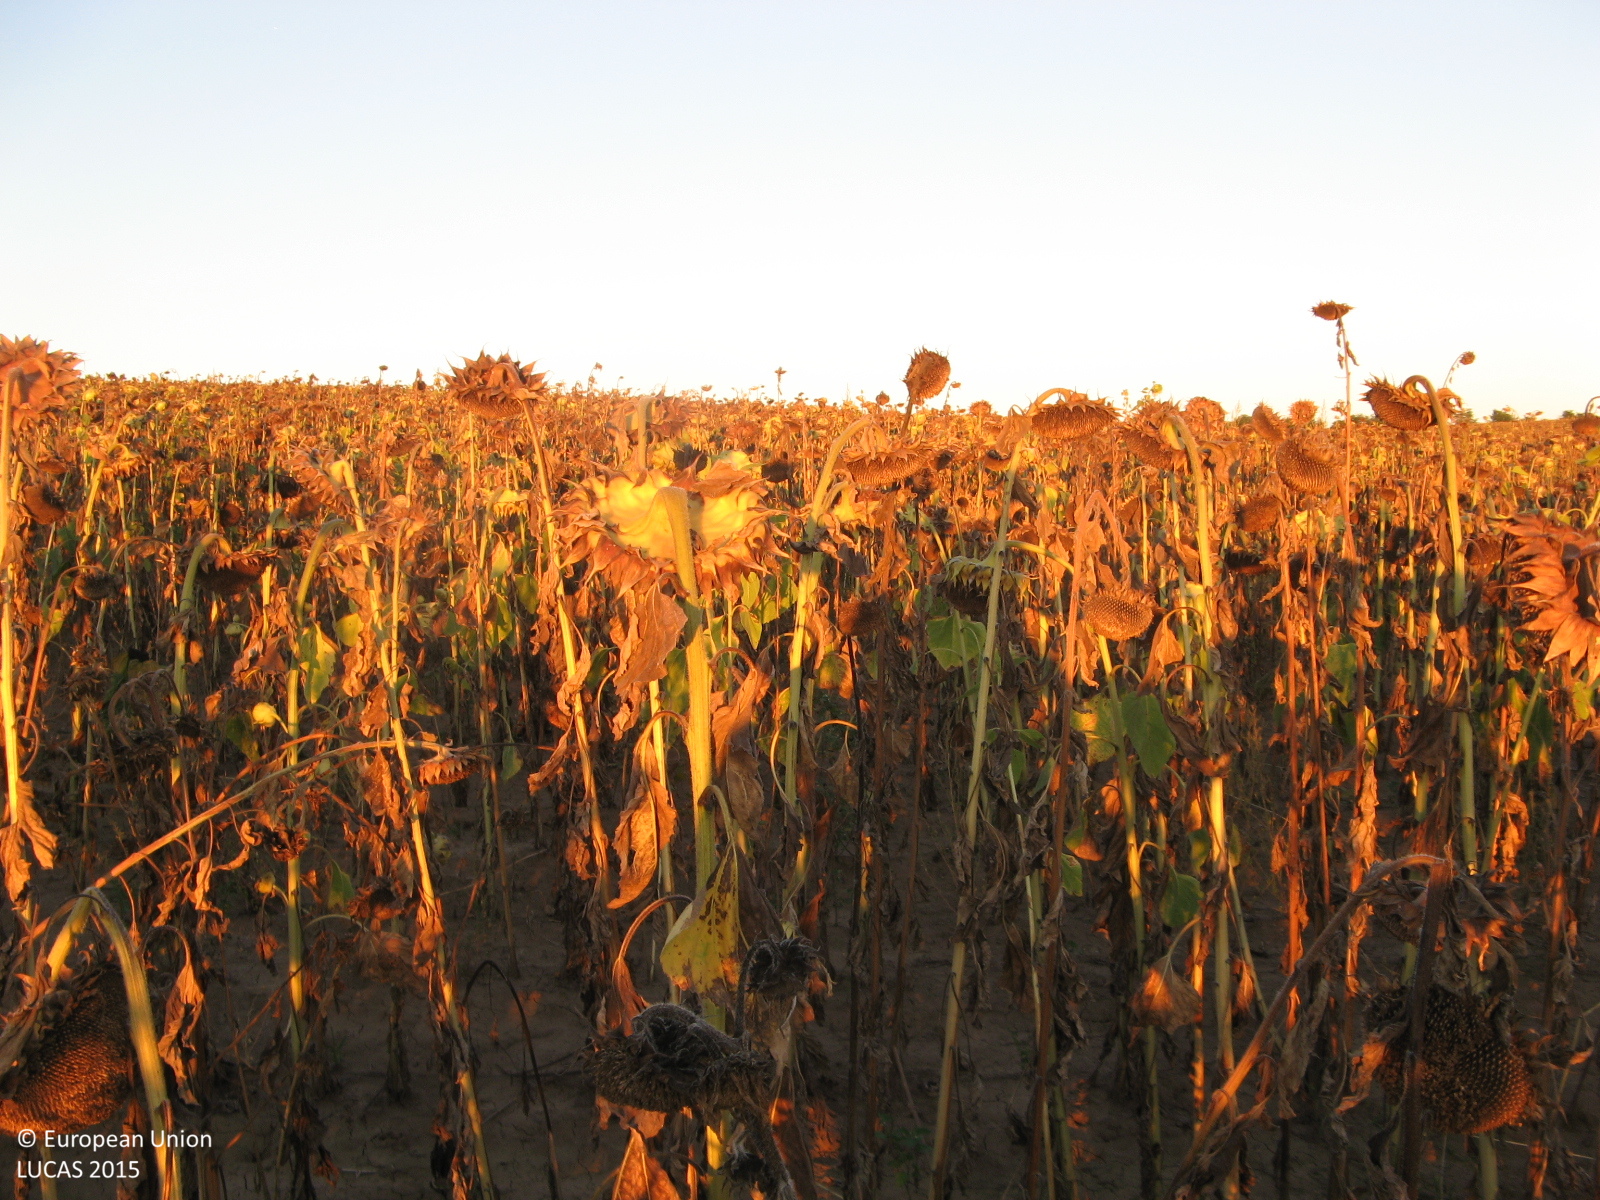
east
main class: Cropland
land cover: Sunflower
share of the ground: > 75 %
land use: Agriculture (excluding fallow land and kitchen gardens)
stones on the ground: < 10 %
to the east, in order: Sunflower
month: September
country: BG
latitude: 43.5681
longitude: 26.0543
